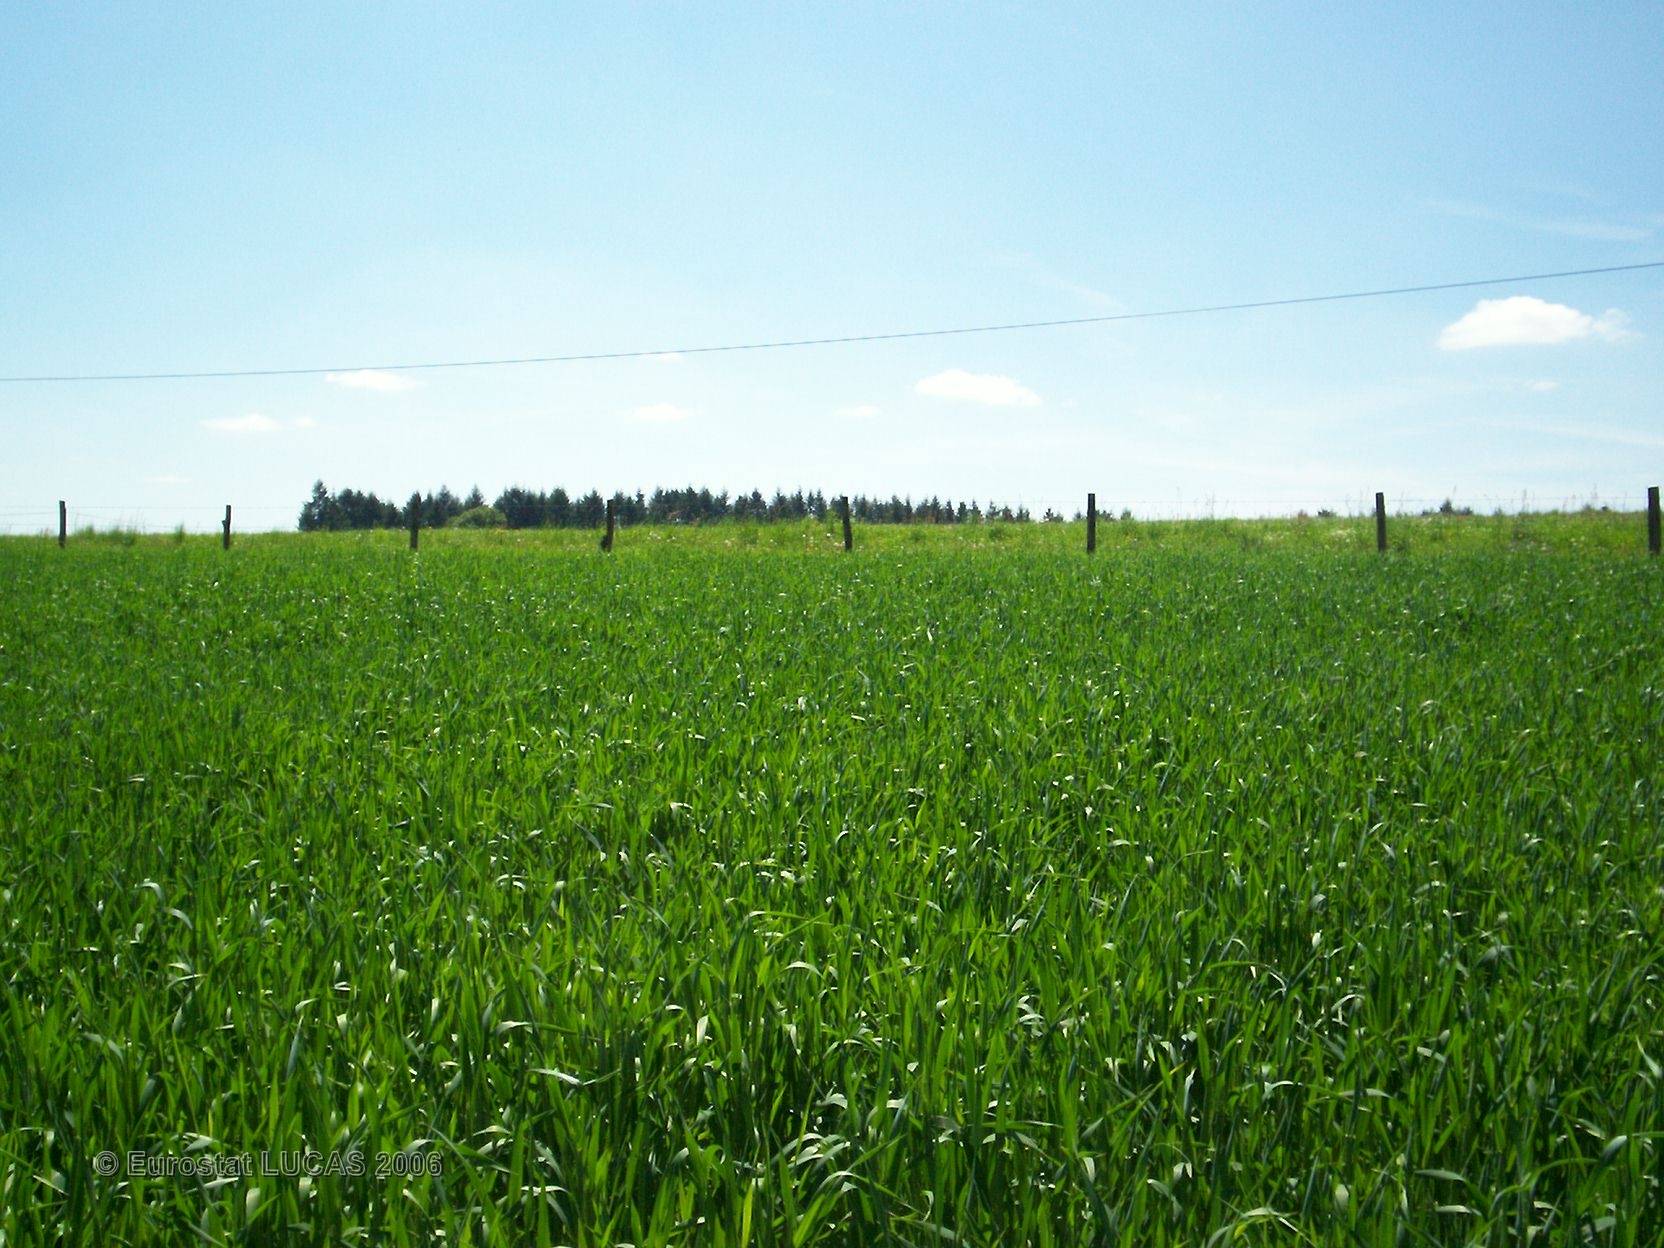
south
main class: Cropland
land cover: Common wheat
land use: Agriculture (excluding fallow land and kitchen gardens)
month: May
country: FR
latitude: 45.8698
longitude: 1.5286
